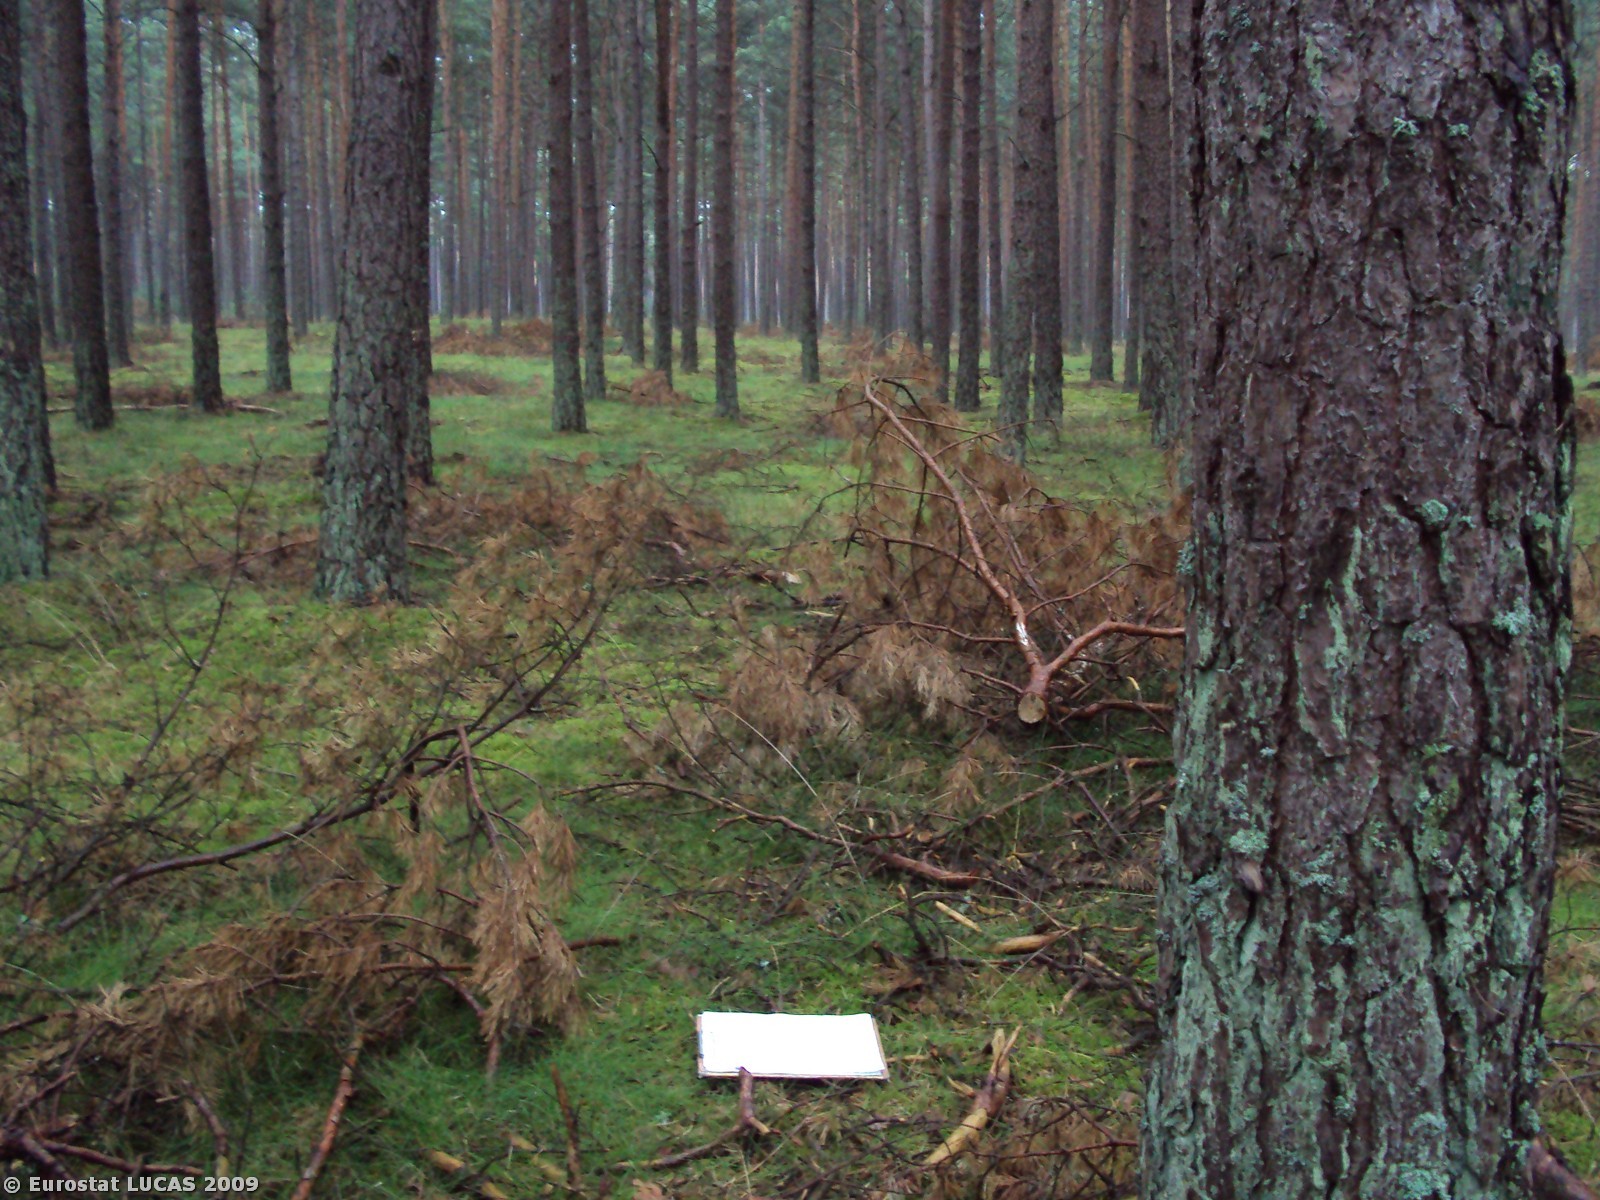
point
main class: Woodland
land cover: Coniferous woodland
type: hemiboreal forest and nemoral coniferous forest and mixed broadleaved-coniferous forest
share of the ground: > 75 %
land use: Forestry
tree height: > 5 m
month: August
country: PL
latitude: 53.2554
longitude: 15.9557
